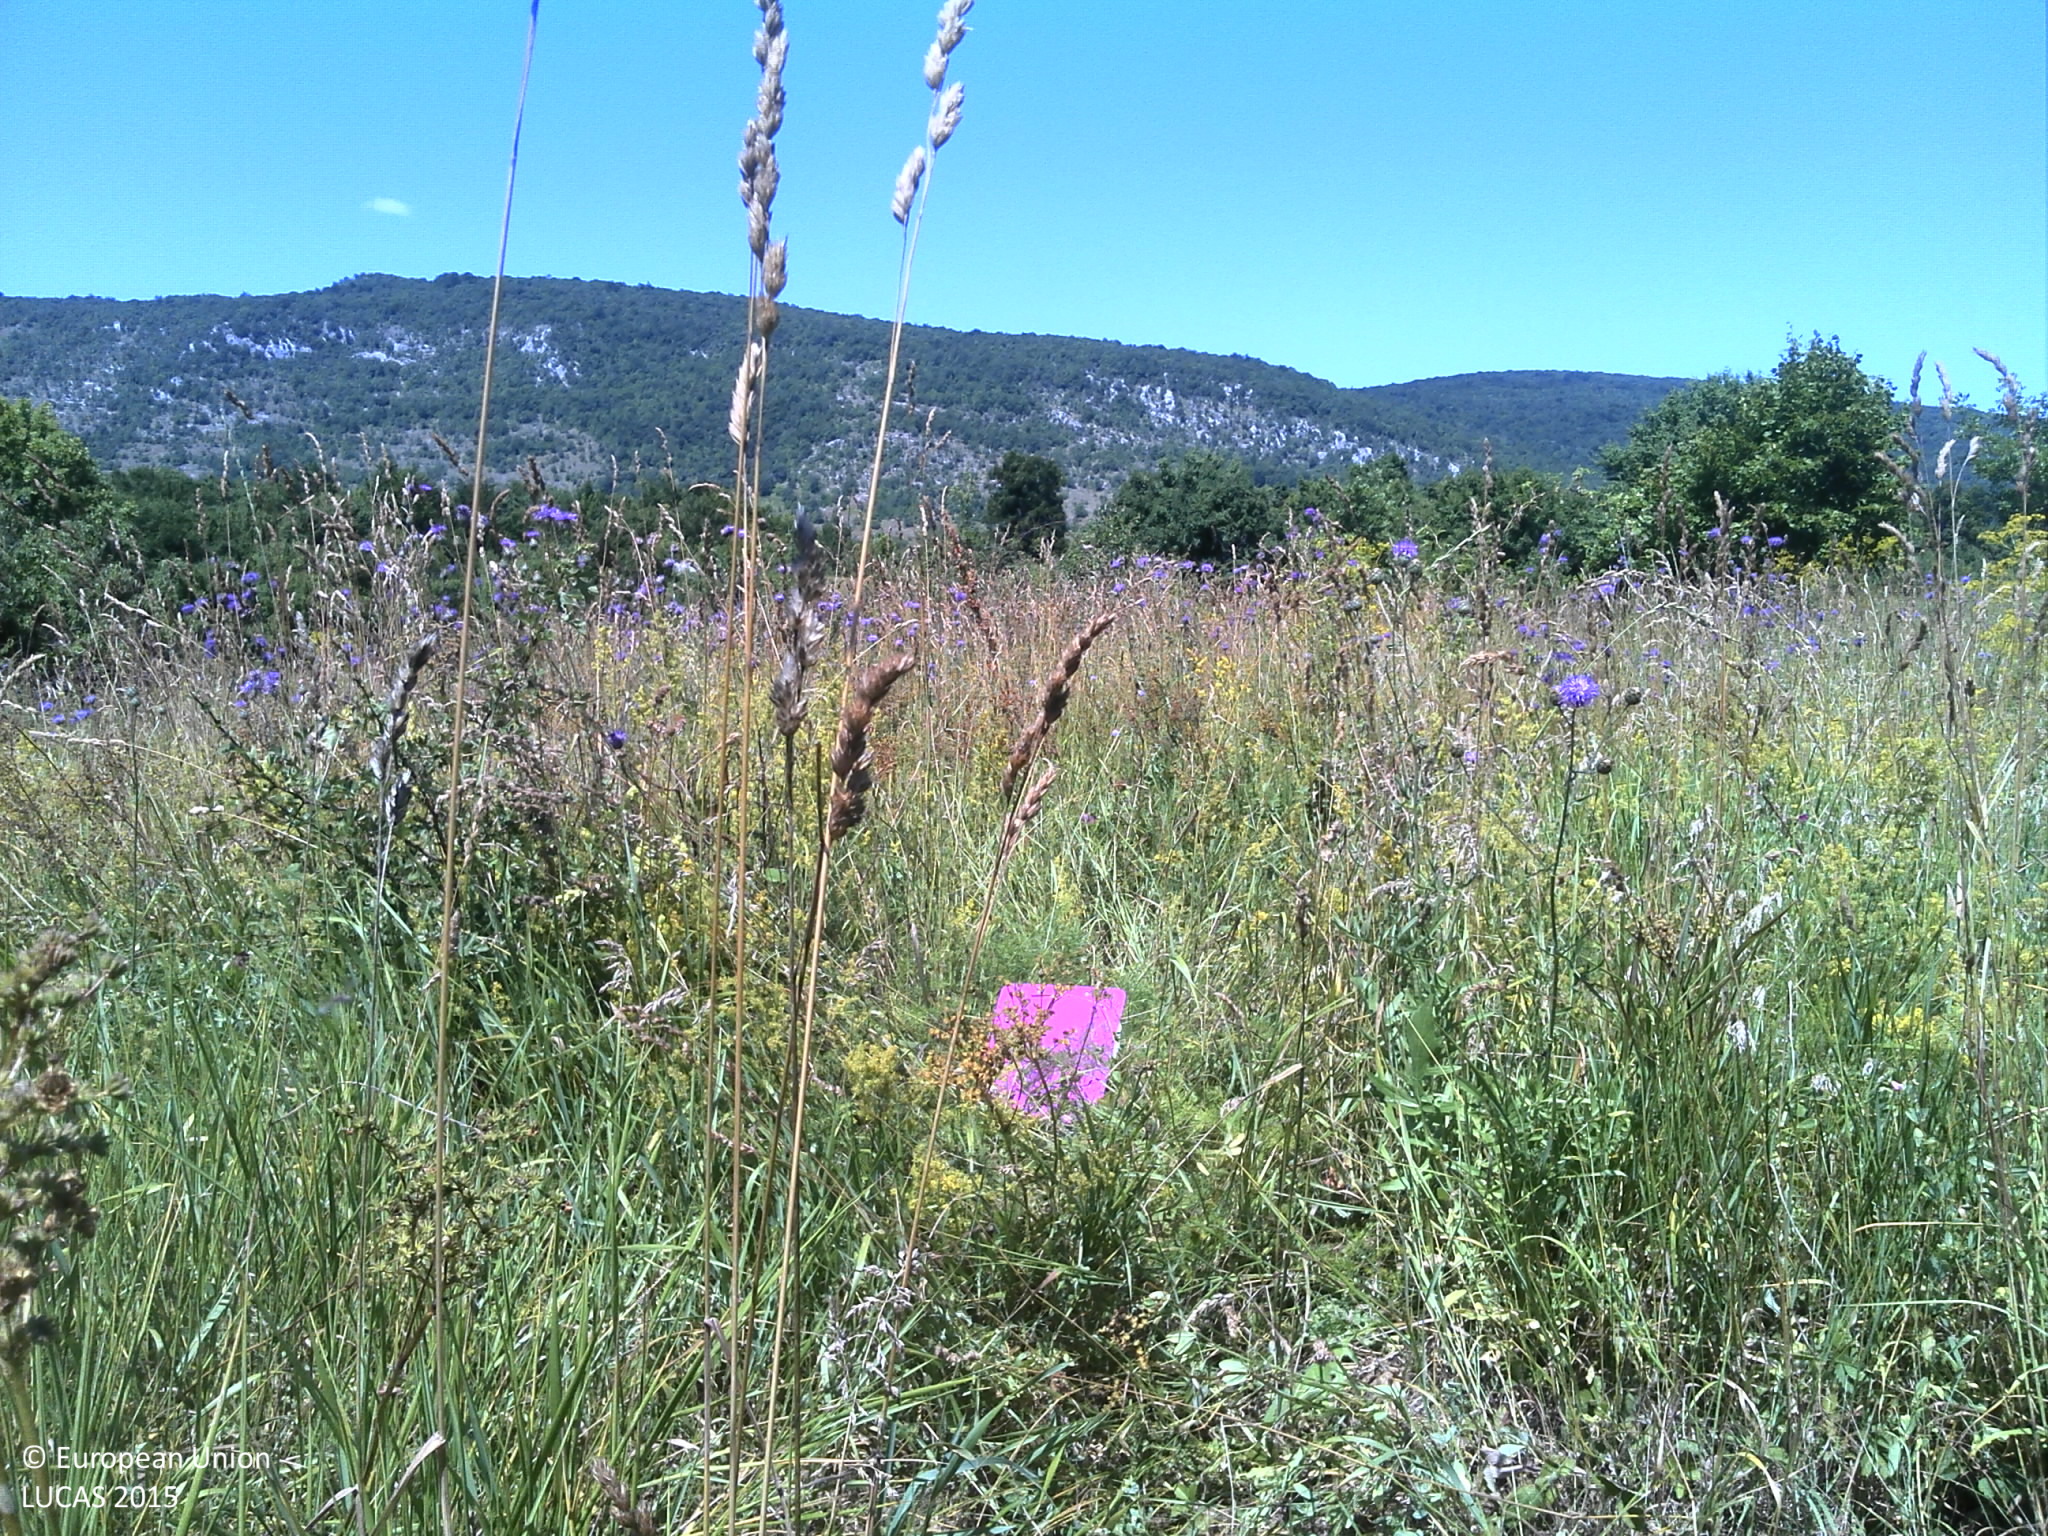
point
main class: Grassland
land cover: Grassland without tree/shrub cover
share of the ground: > 75 %
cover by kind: herbaceous plants 95 %, shrubs 5 %
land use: Semi-natural and natural areas not in use
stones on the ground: < 10 %
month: July
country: HR
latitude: 44.9247
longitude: 15.2014
